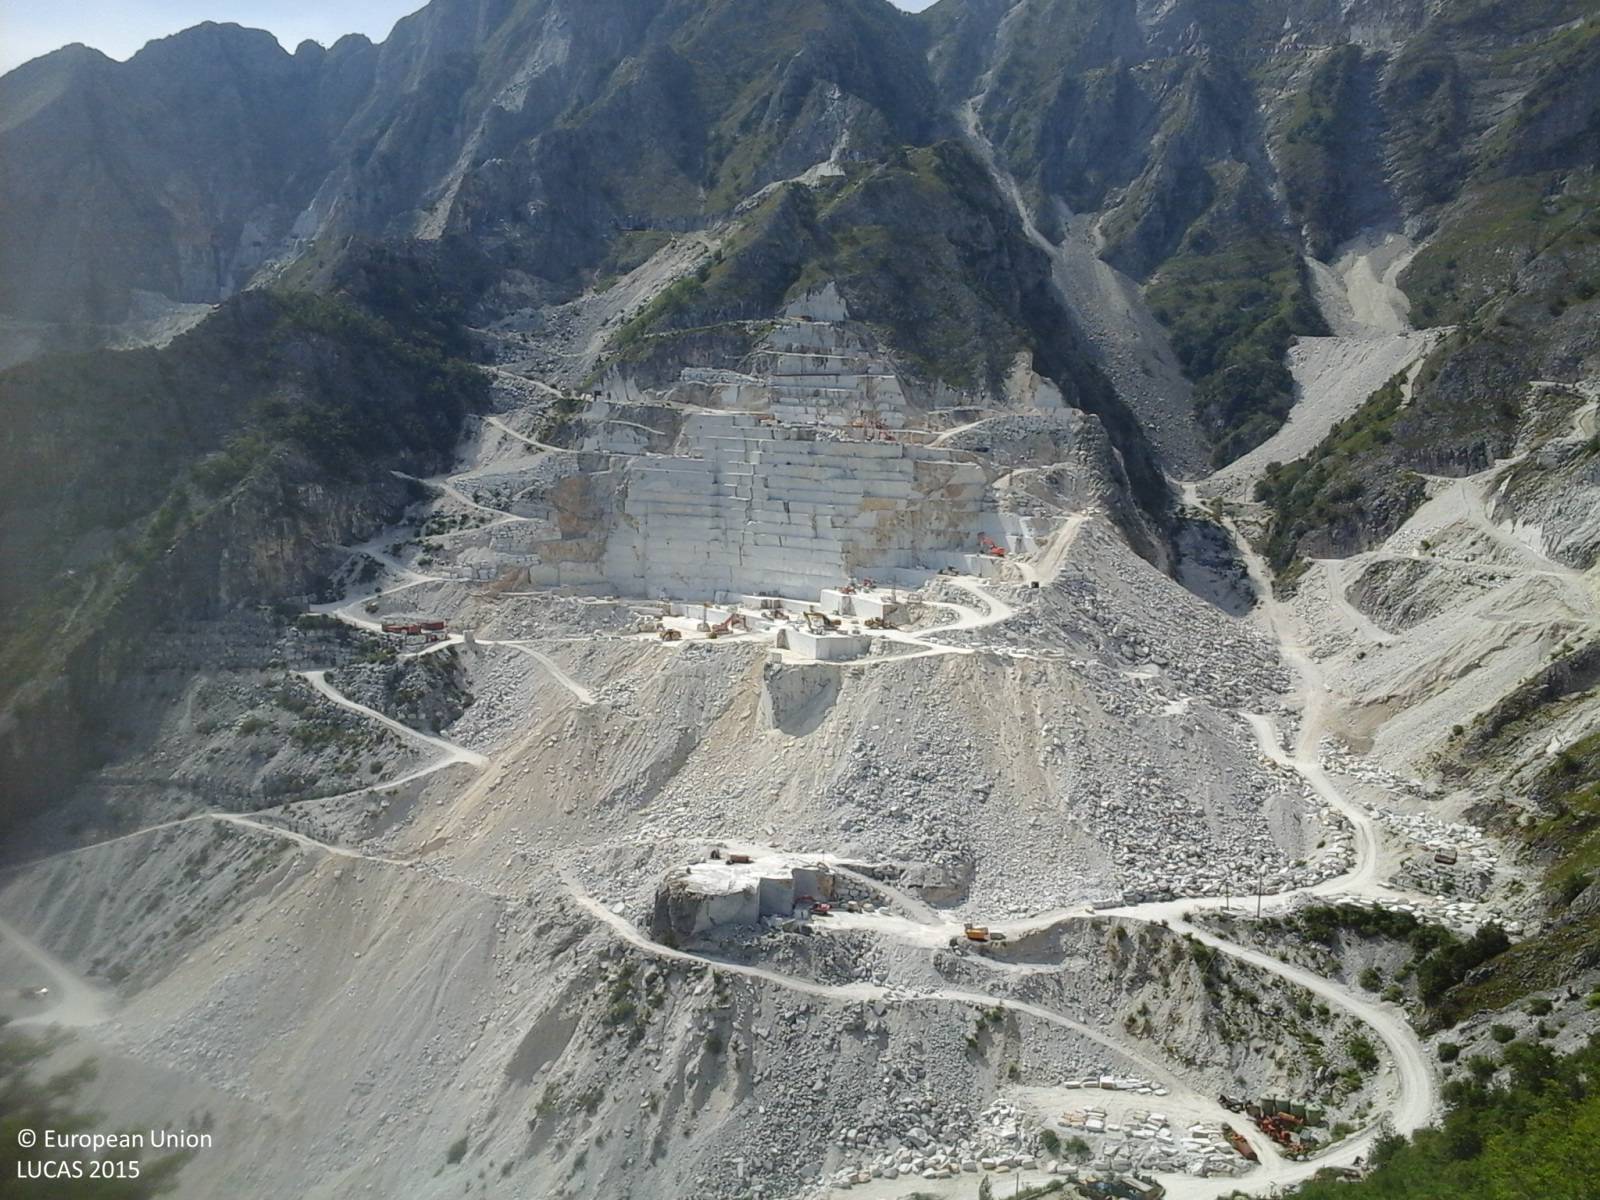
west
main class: Grassland
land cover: Grassland with sparse tree/shrub cover
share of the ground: > 75 %
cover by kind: herbaceous plants 75 %, shrubs 10 %, unconsolidated bare surface 10 %, broadleaved forest trees 5 %
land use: Semi-natural and natural areas not in use
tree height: > 5 m
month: June
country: IT
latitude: 44.0979
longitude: 10.1620
